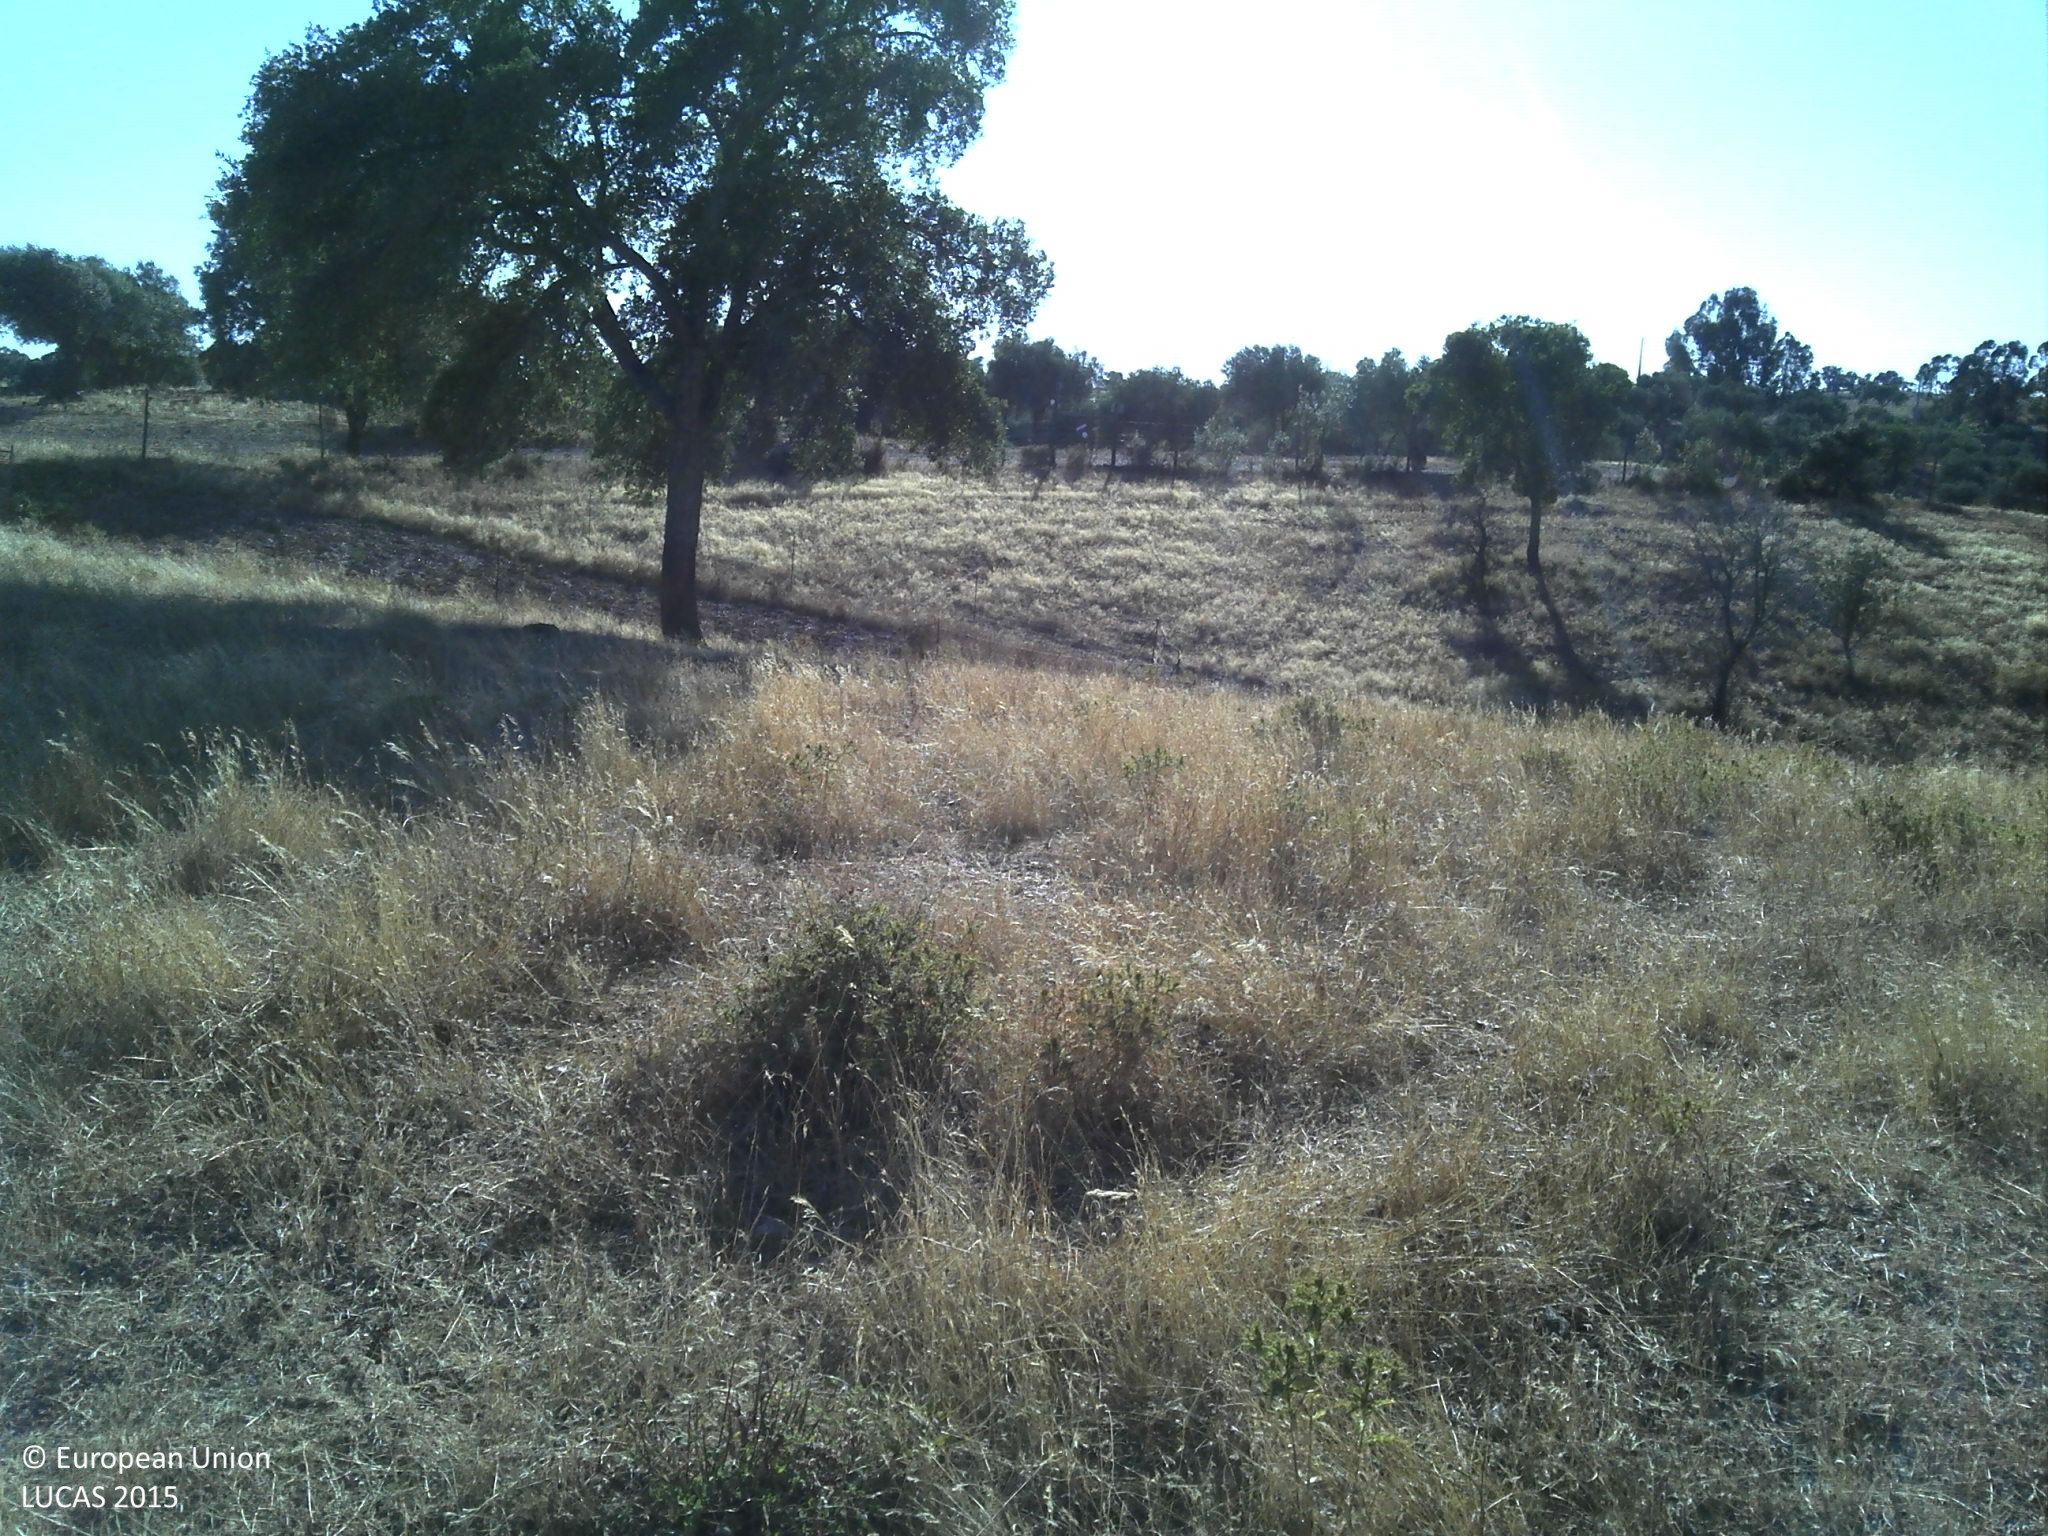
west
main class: Woodland
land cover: Broadleaved woodland
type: broadleaved evergreen forest
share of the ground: 10 - 25 %
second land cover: Grassland without tree/shrub cover
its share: 10 - 25 %
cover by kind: unconsolidated bare surface 40 %, herbaceous plants 25 %, broadleaved forest trees 15 %, shrubs 5 %
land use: Forestry
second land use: Agriculture (excluding fallow land and kitchen gardens)
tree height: > 5 m
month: June
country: PT
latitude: 37.8457
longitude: -7.3198
